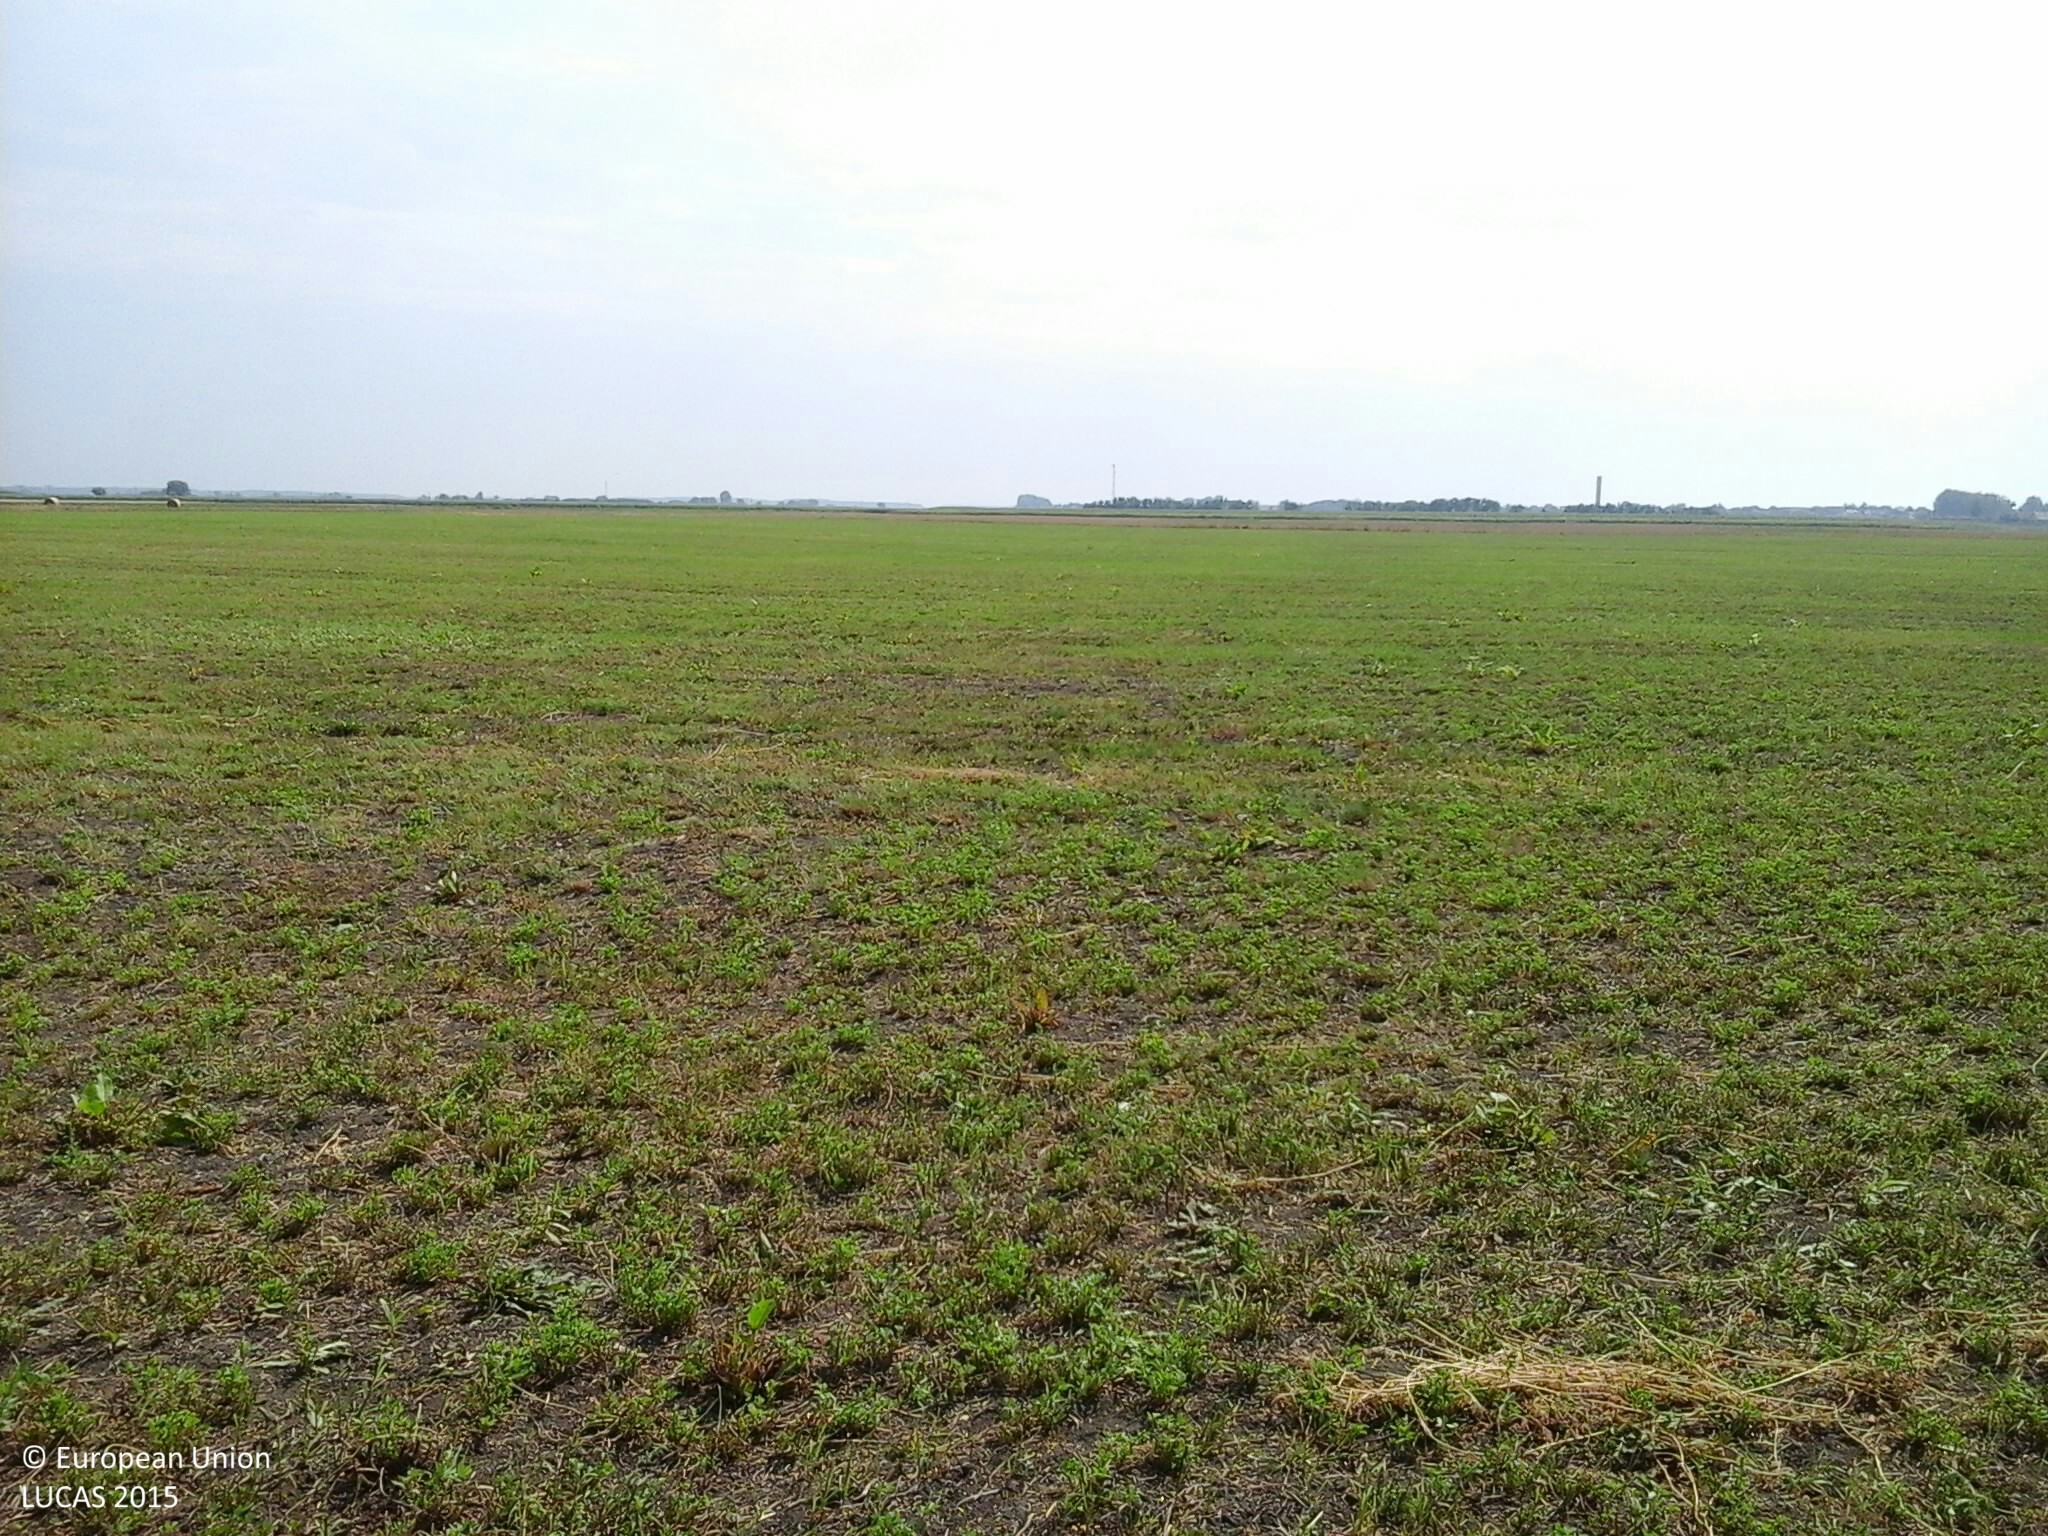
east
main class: Cropland
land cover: Lucerne
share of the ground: 50 - 75 %
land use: Agriculture (excluding fallow land and kitchen gardens)
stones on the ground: < 10 %
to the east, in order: Lucerne; Common wheat
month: August
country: HU
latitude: 47.7096
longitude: 20.9798
